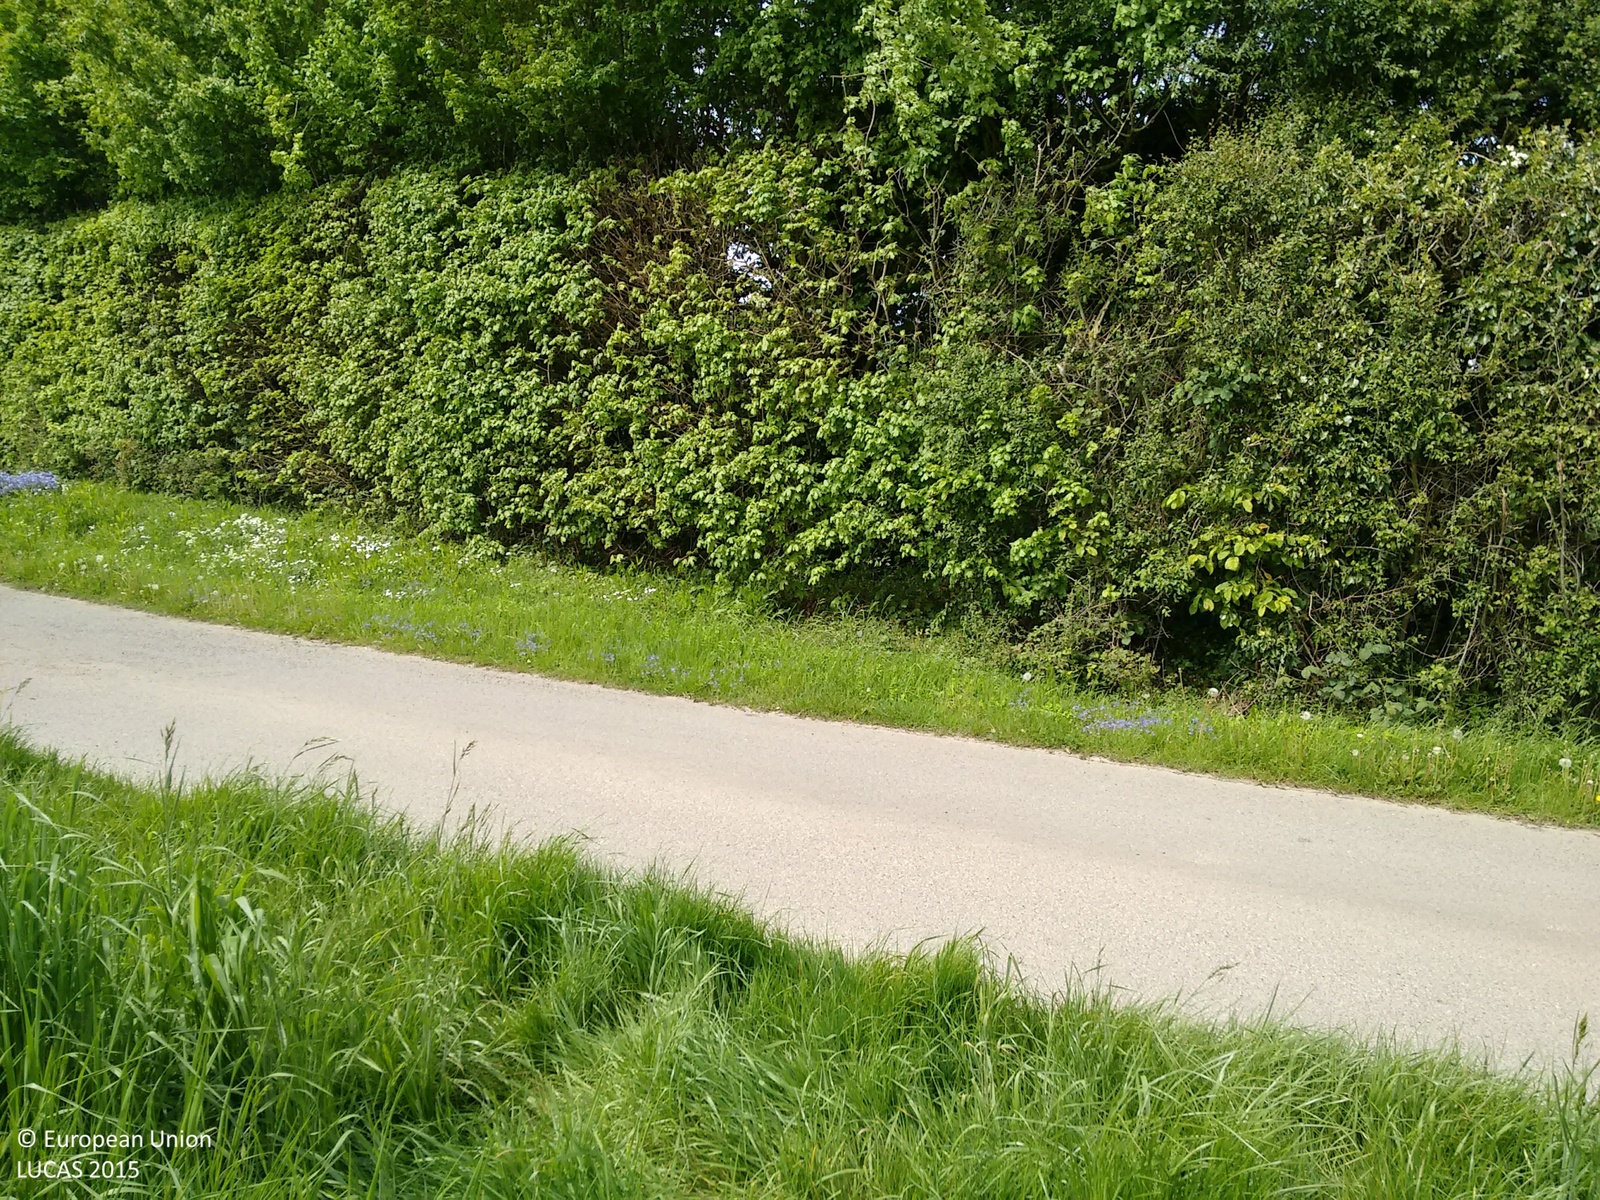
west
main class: Cropland
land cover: Rape and turnip rape
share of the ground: > 75 %
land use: Agriculture (excluding fallow land and kitchen gardens)
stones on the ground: < 10 %
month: May
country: GB
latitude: 51.1836
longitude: 0.3135
